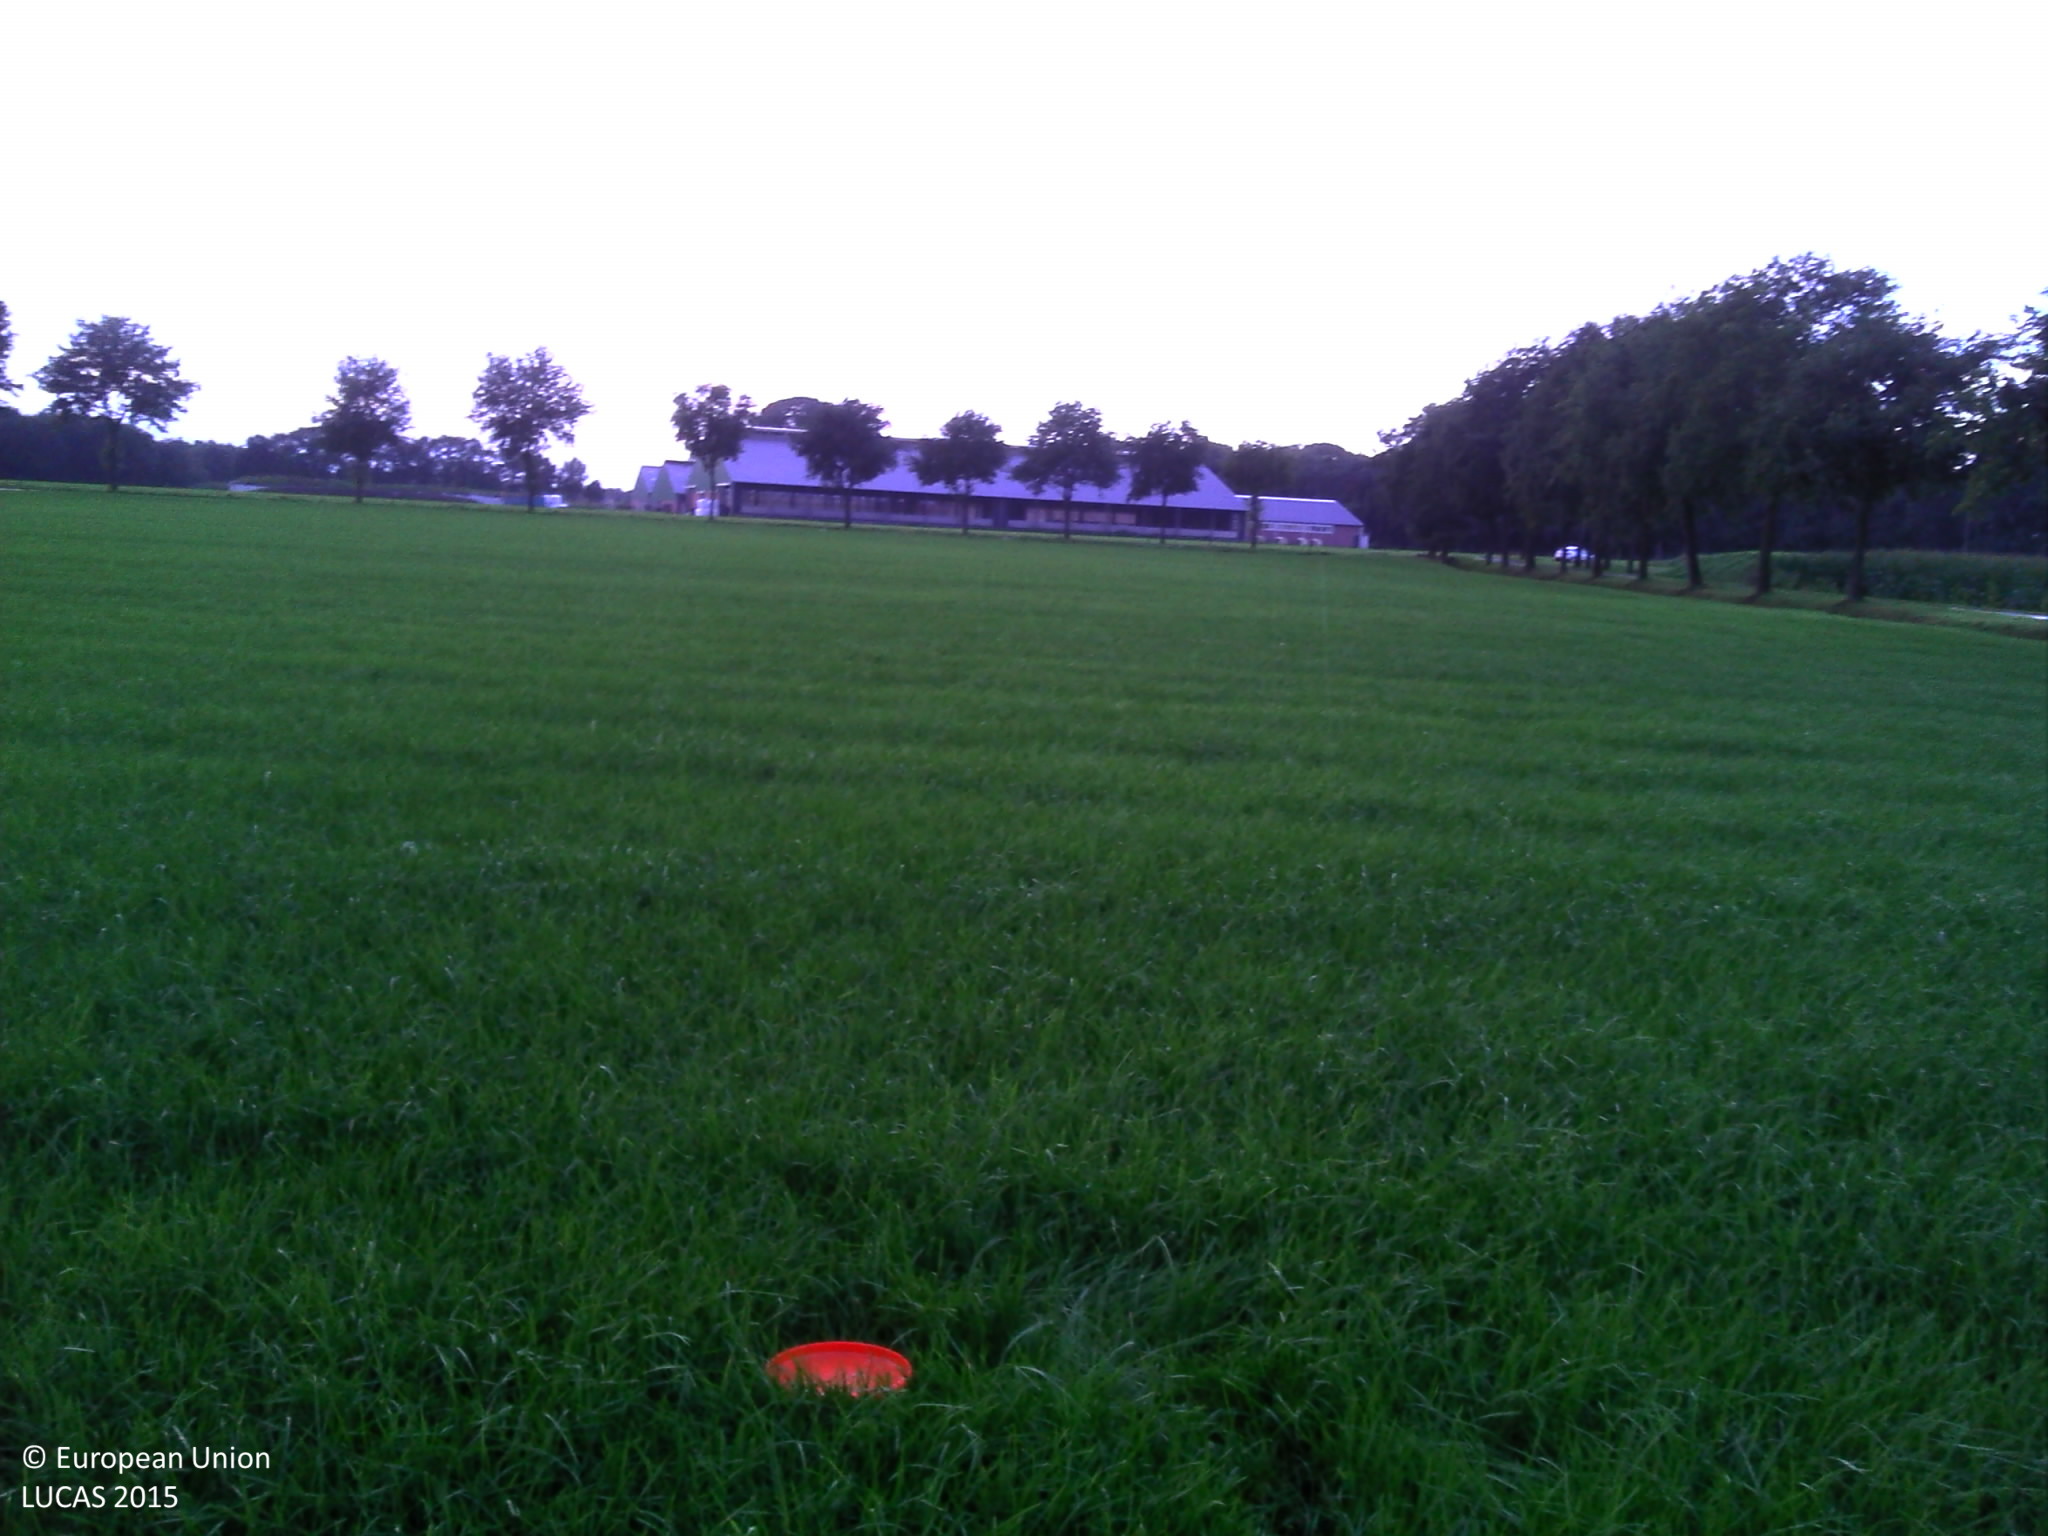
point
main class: Cropland
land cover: Temporary grasslands
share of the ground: > 75 %
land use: Agriculture (excluding fallow land and kitchen gardens)
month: September
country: BE
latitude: 51.3351
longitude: 4.5847
